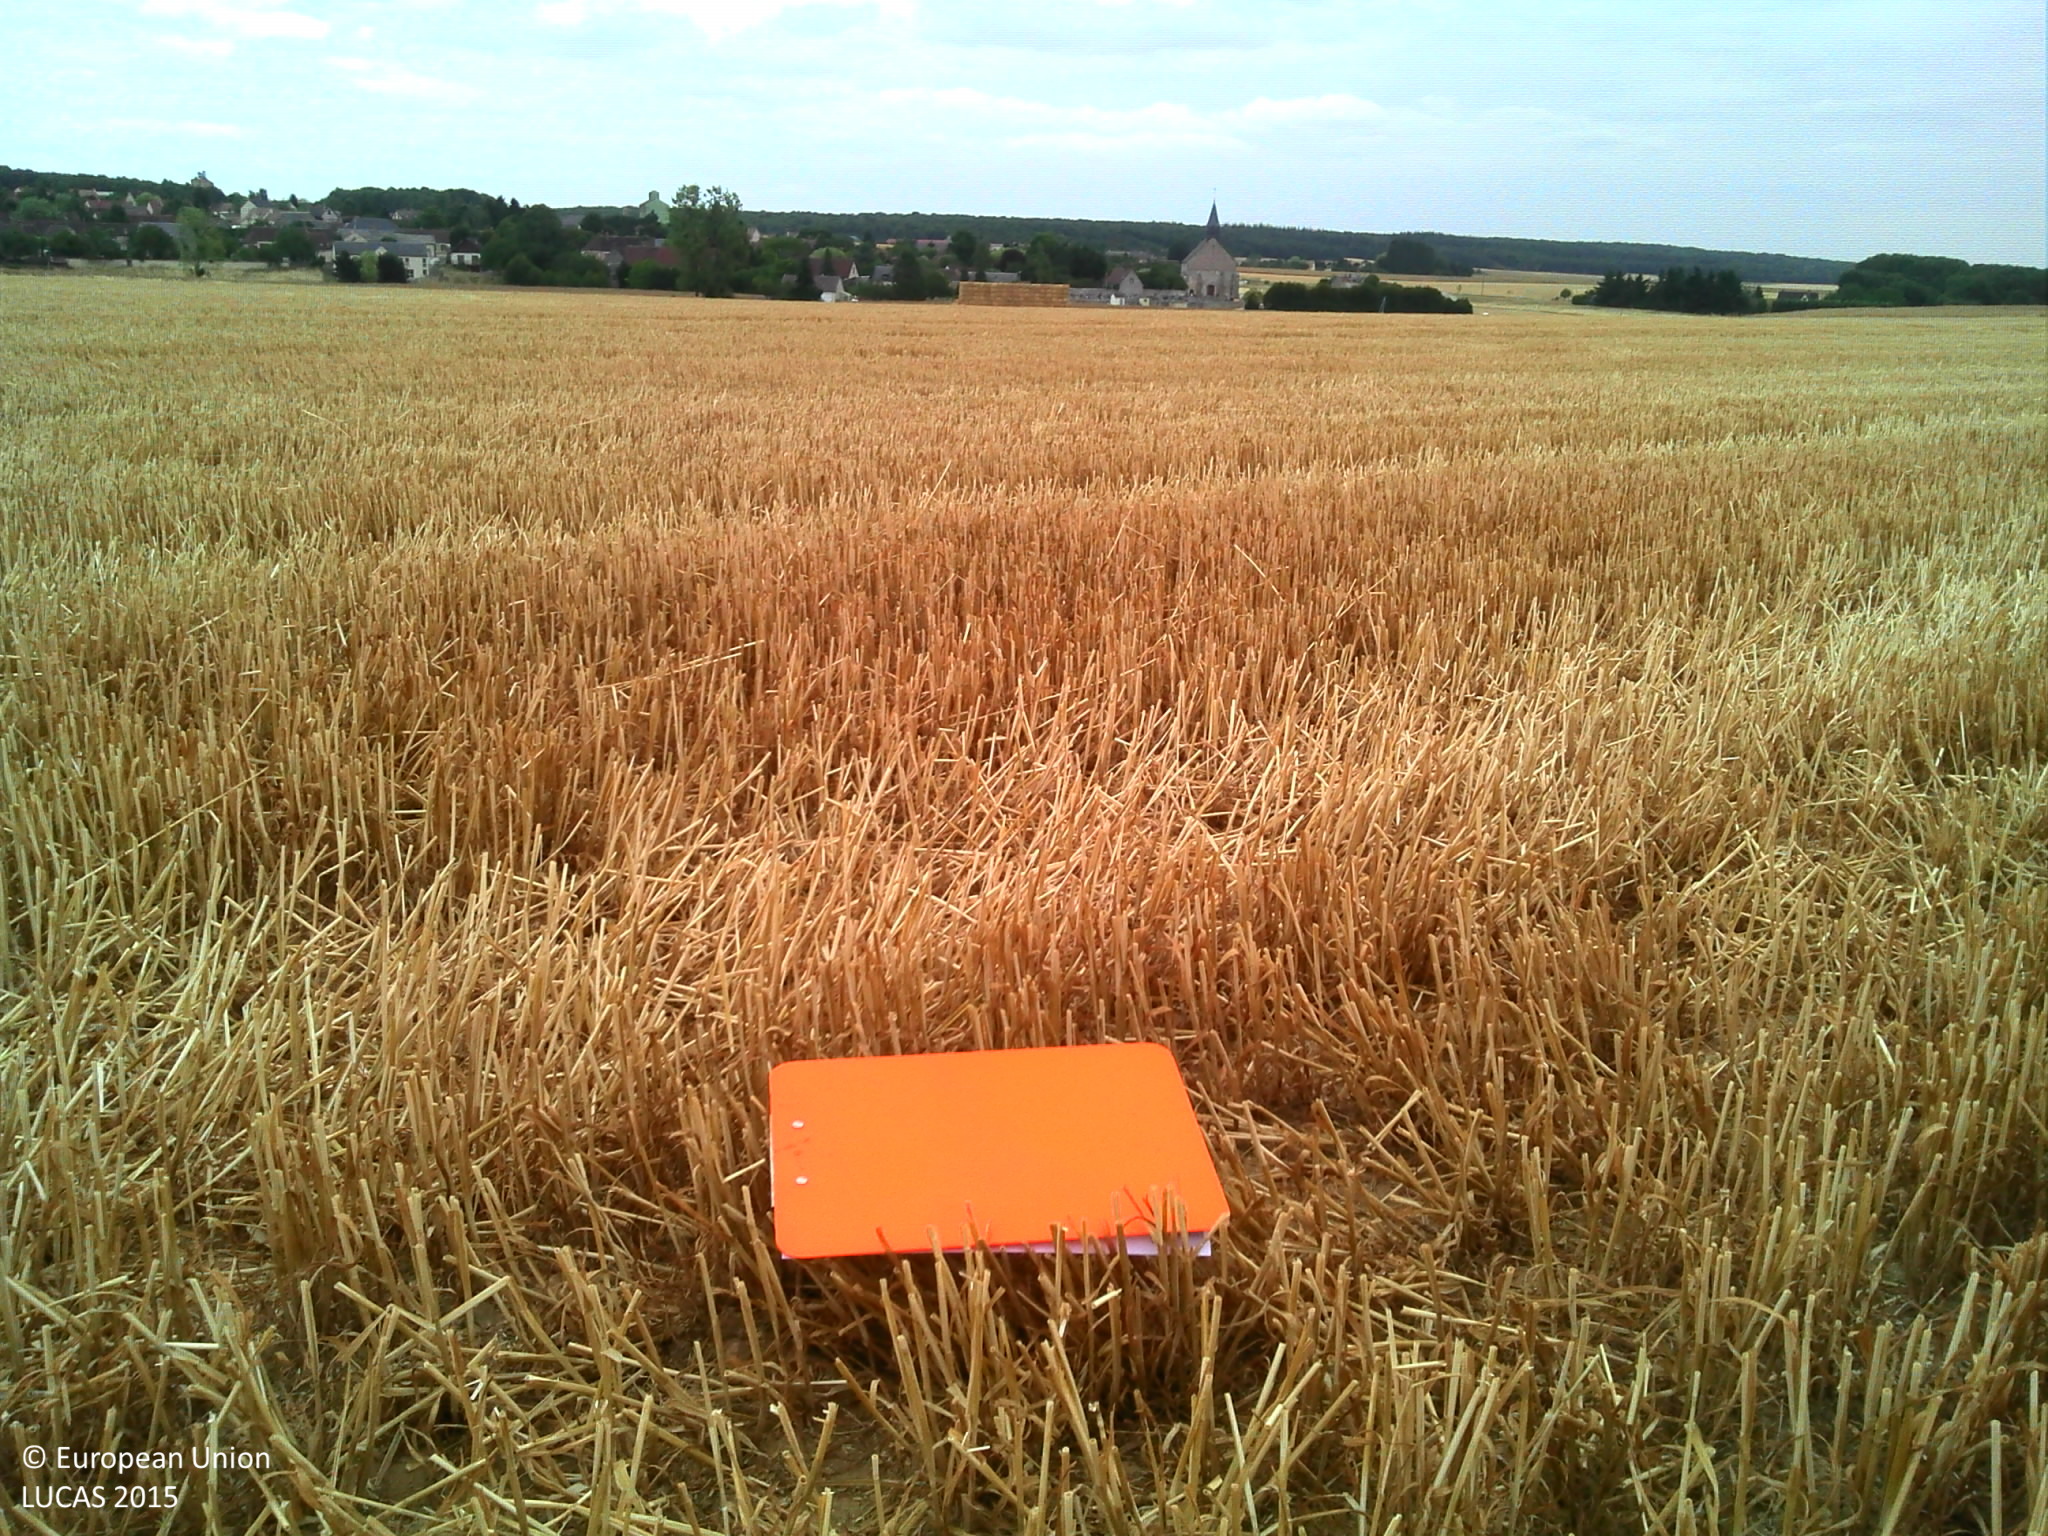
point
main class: Cropland
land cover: Common wheat
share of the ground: > 75 %
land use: Agriculture (excluding fallow land and kitchen gardens)
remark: Harvested field
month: July
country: FR
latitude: 48.4907
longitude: 1.2537
